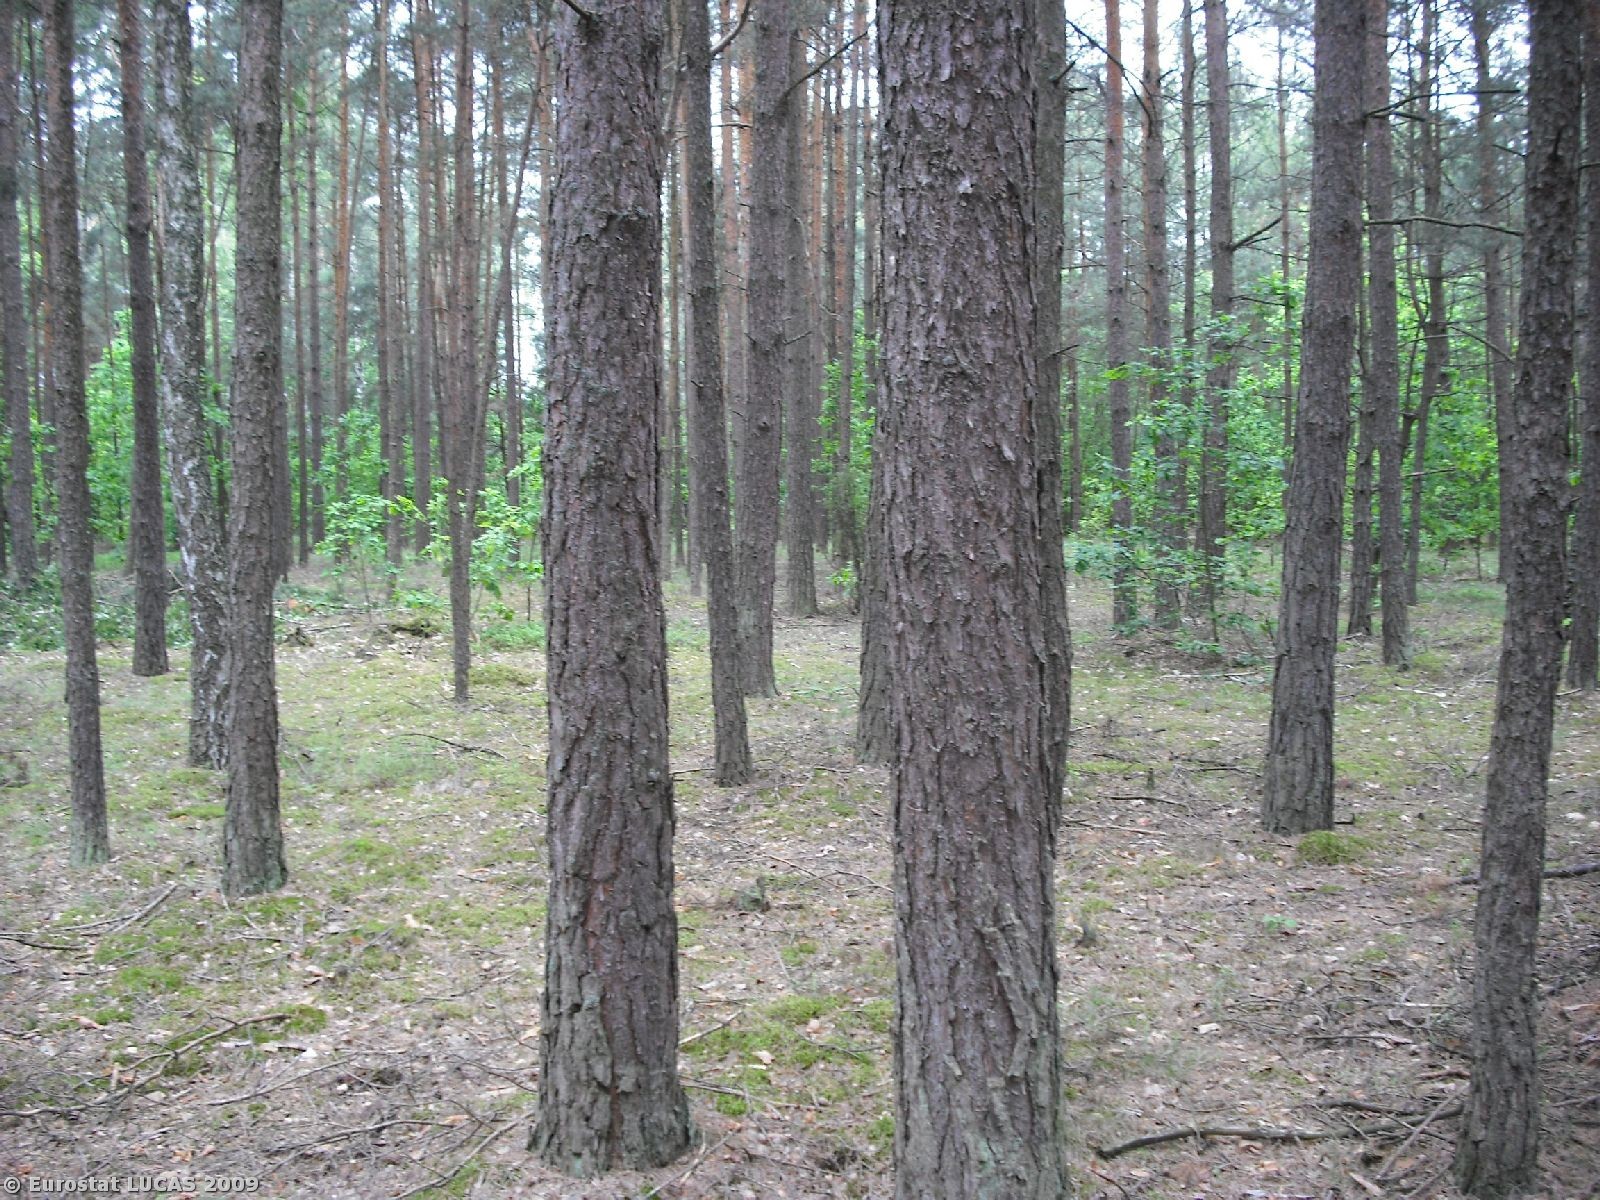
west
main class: Woodland
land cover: Coniferous woodland
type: hemiboreal forest and nemoral coniferous forest and mixed broadleaved-coniferous forest
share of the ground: > 75 %
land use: Forestry
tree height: > 5 m
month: June
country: PL
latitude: 52.7076
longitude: 22.3934
